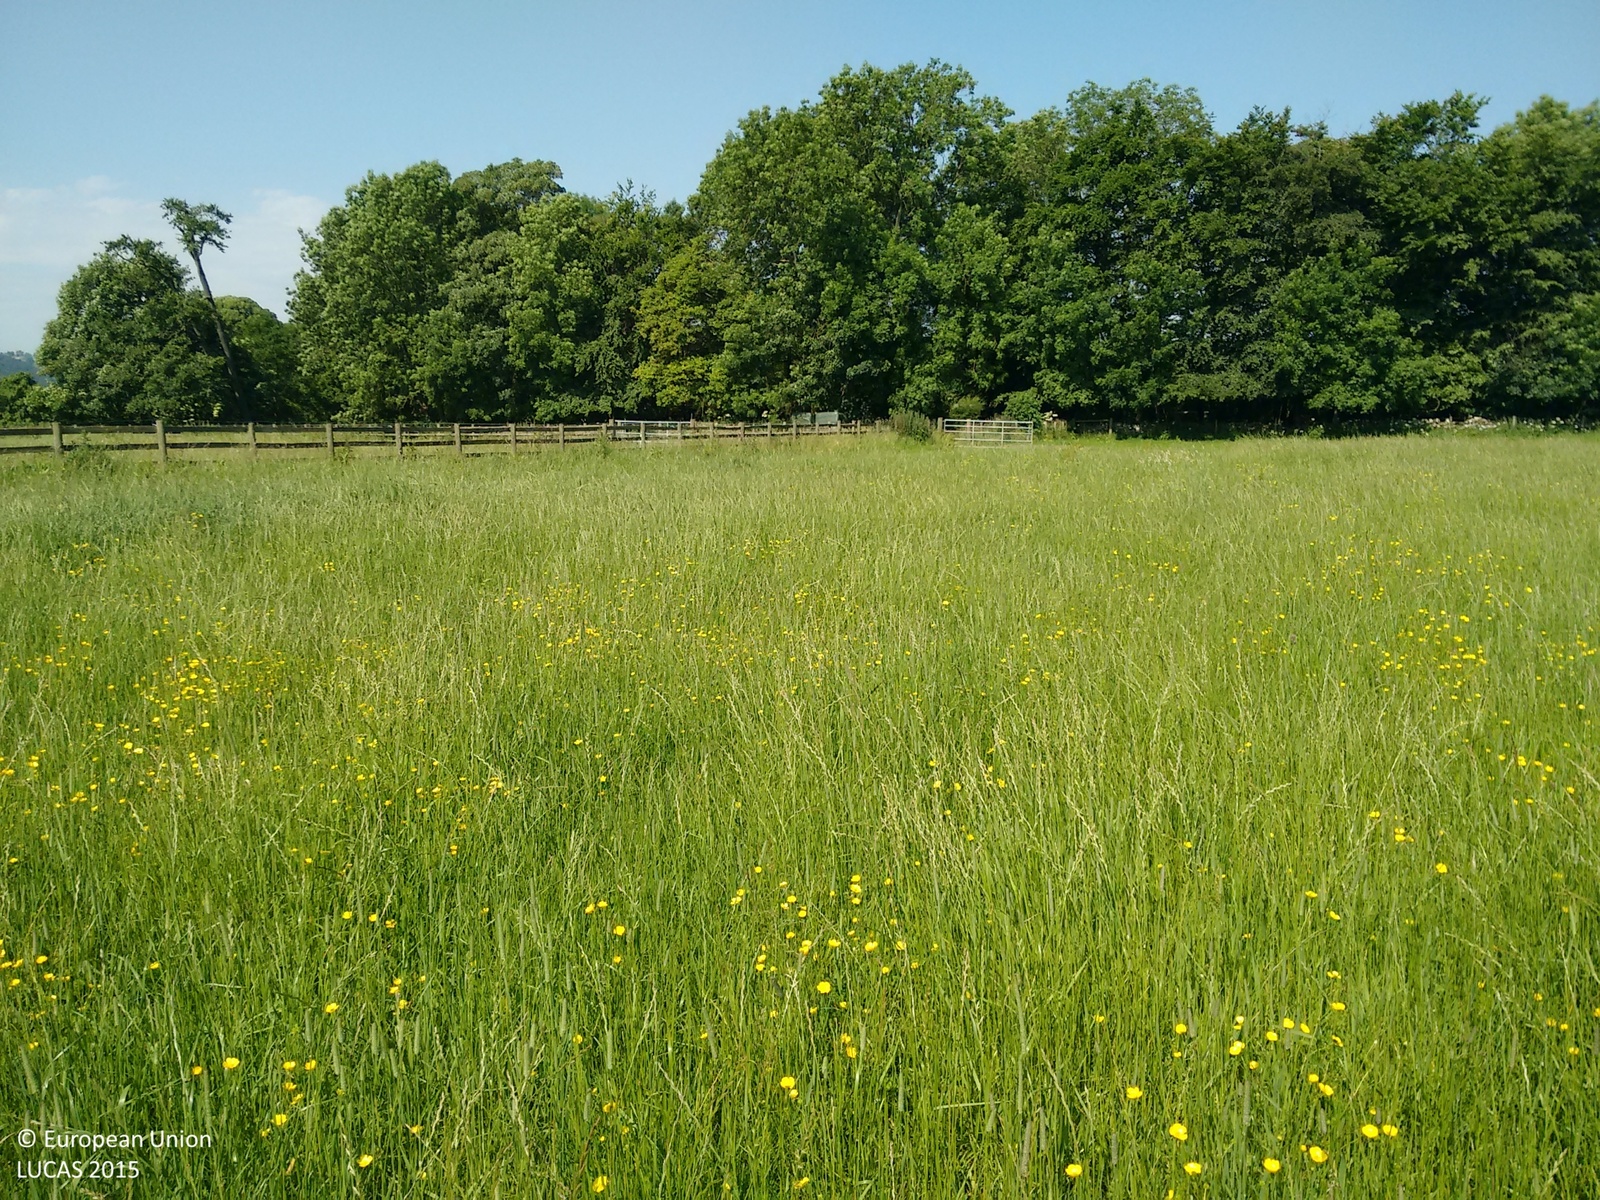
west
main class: Grassland
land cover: Grassland without tree/shrub cover
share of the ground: > 75 %
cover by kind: herbaceous plants 100 %
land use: Agriculture (excluding fallow land and kitchen gardens)
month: July
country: GB
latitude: 53.2329
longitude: -1.6937
